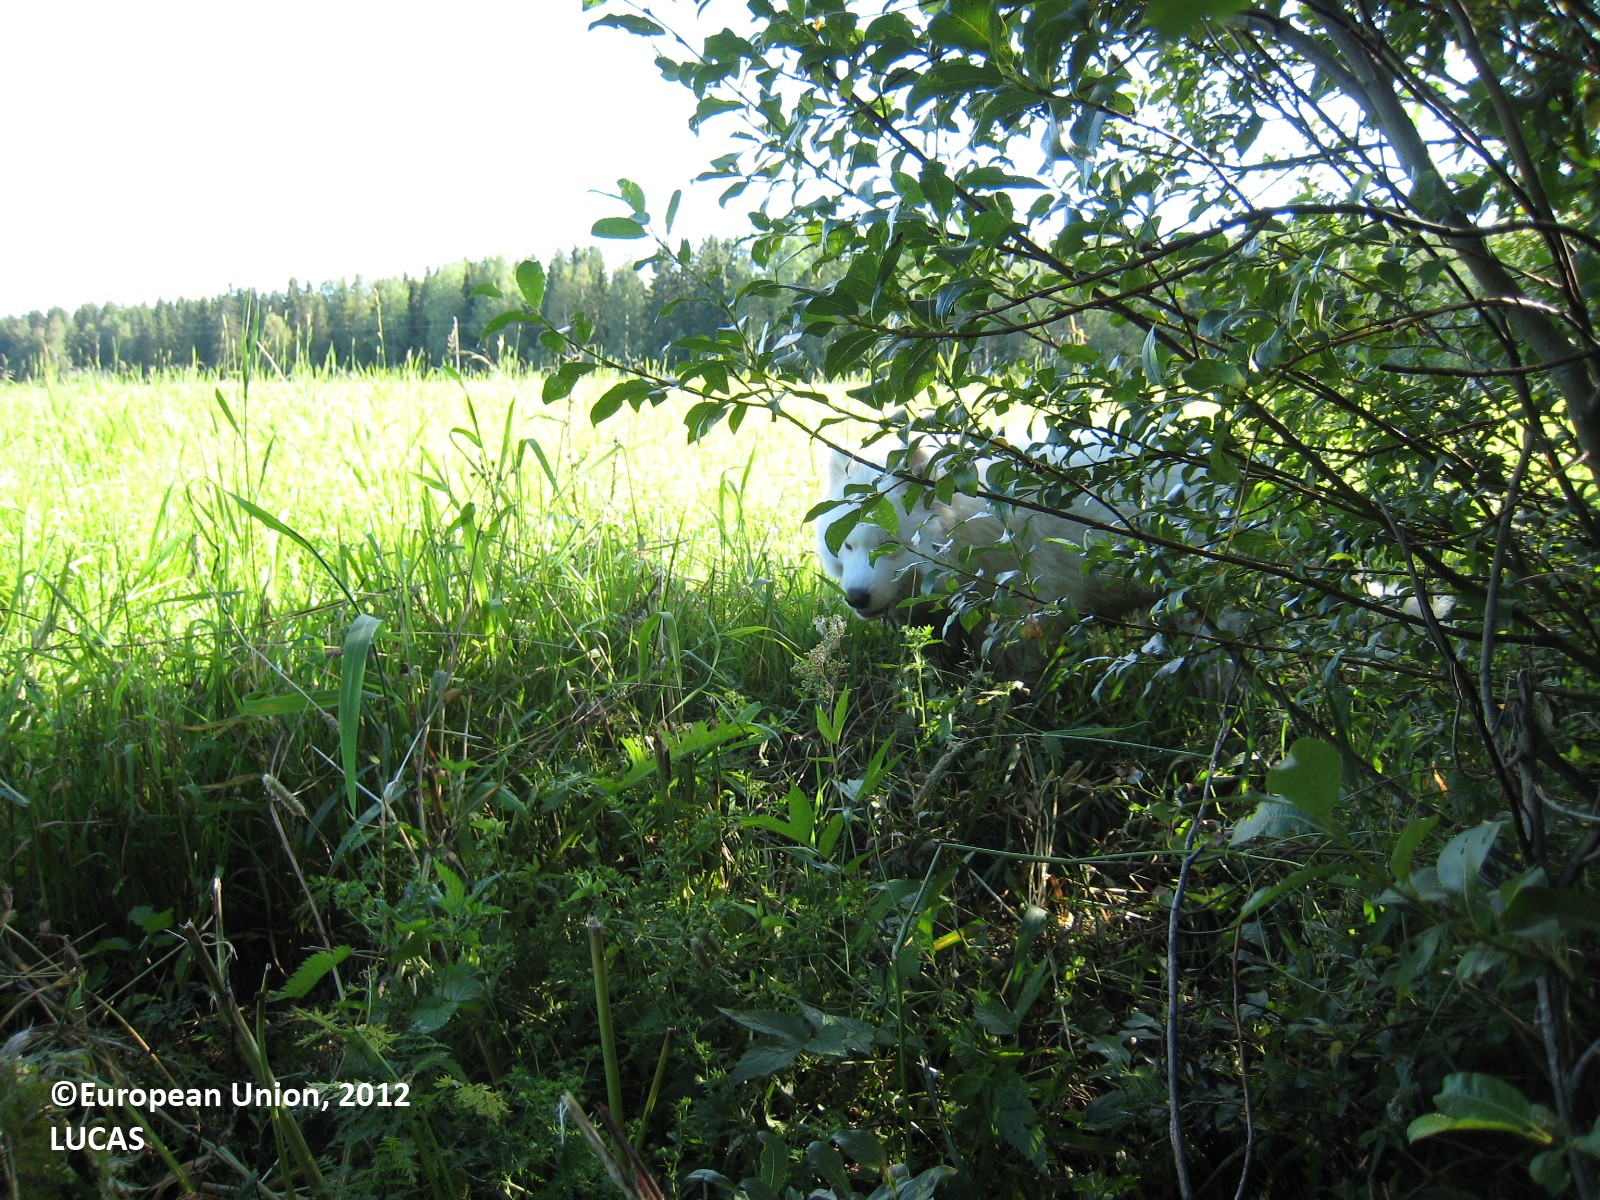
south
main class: Woodland
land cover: Broadleaved woodland
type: non-riverine alder, birch or aspen forest
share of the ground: > 75 %
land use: Forestry
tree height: > 5 m
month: July
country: FI
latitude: 62.8891
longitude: 26.7207
